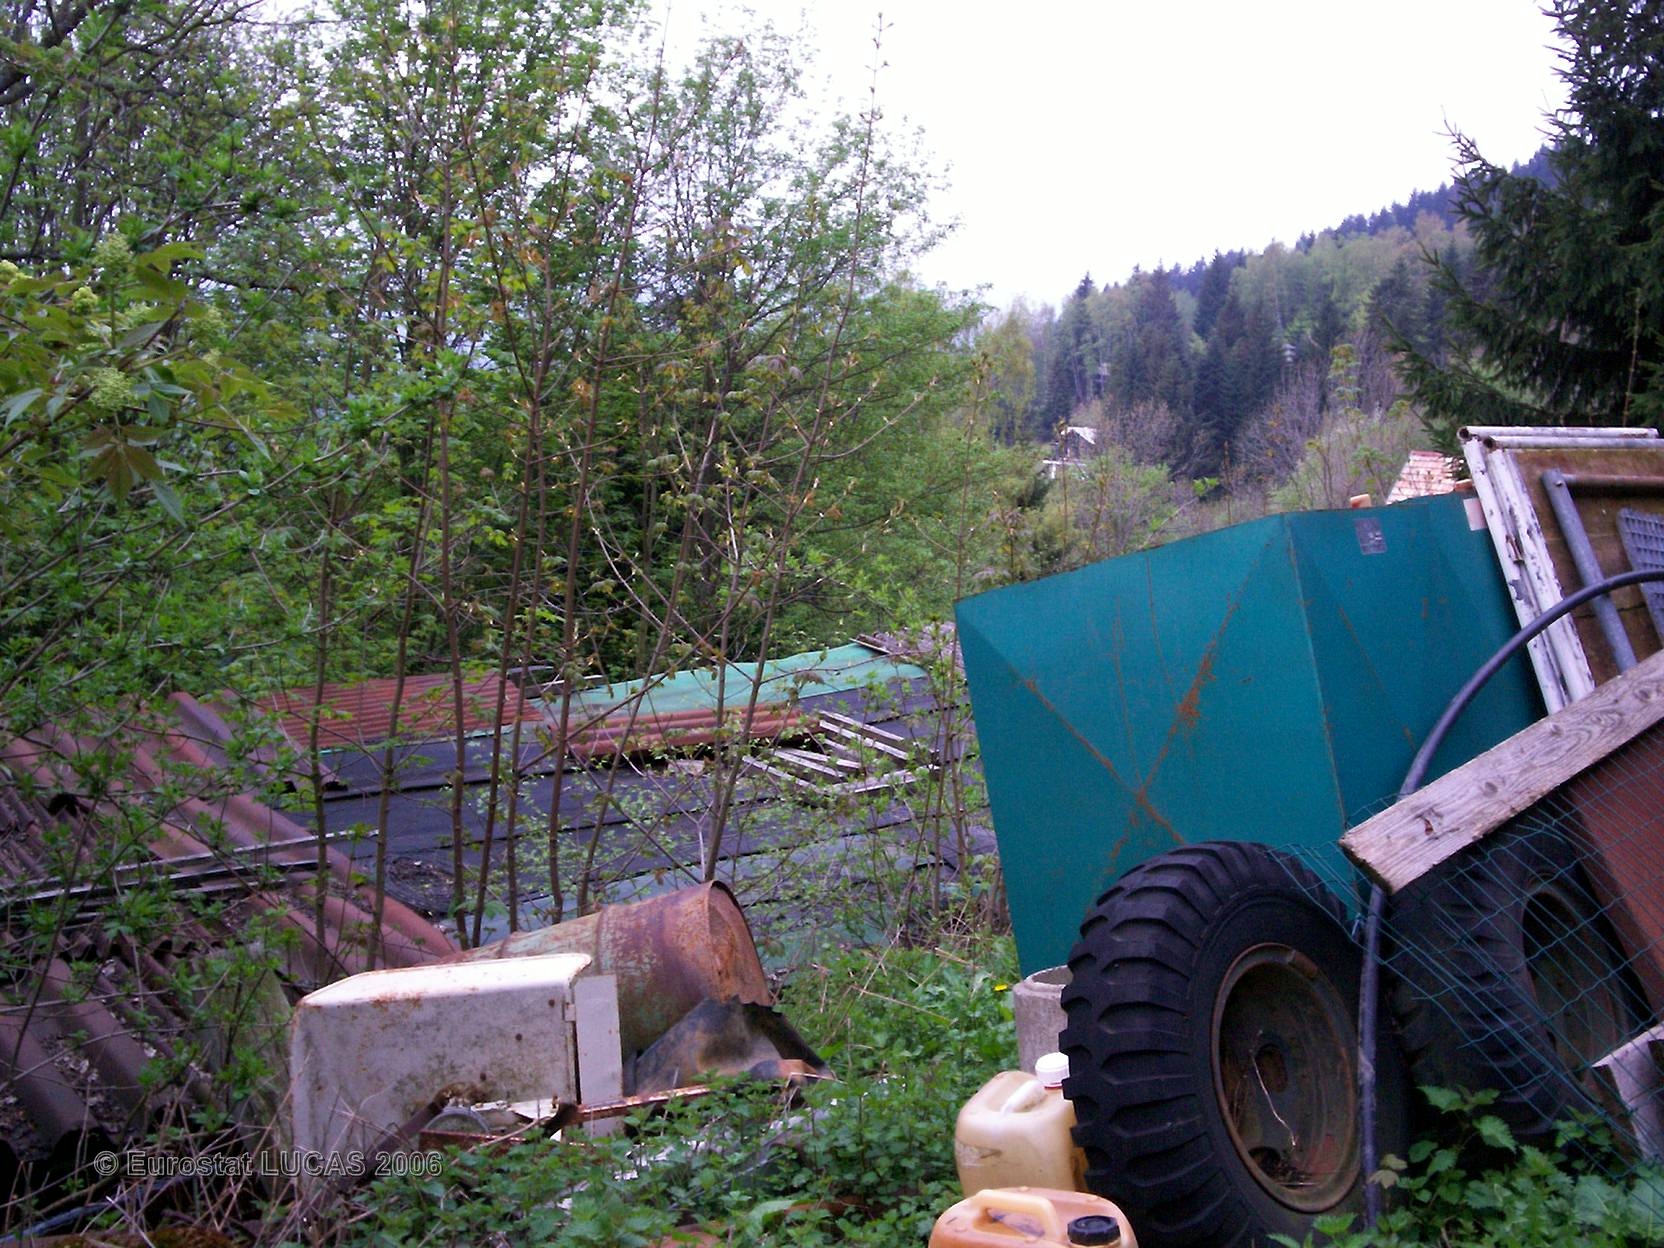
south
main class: Grassland
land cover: Grassland with sparse tree/shrub cover
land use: Agriculture (excluding fallow land and kitchen gardens)
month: May
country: FR
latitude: 47.9512
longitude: 7.0956
